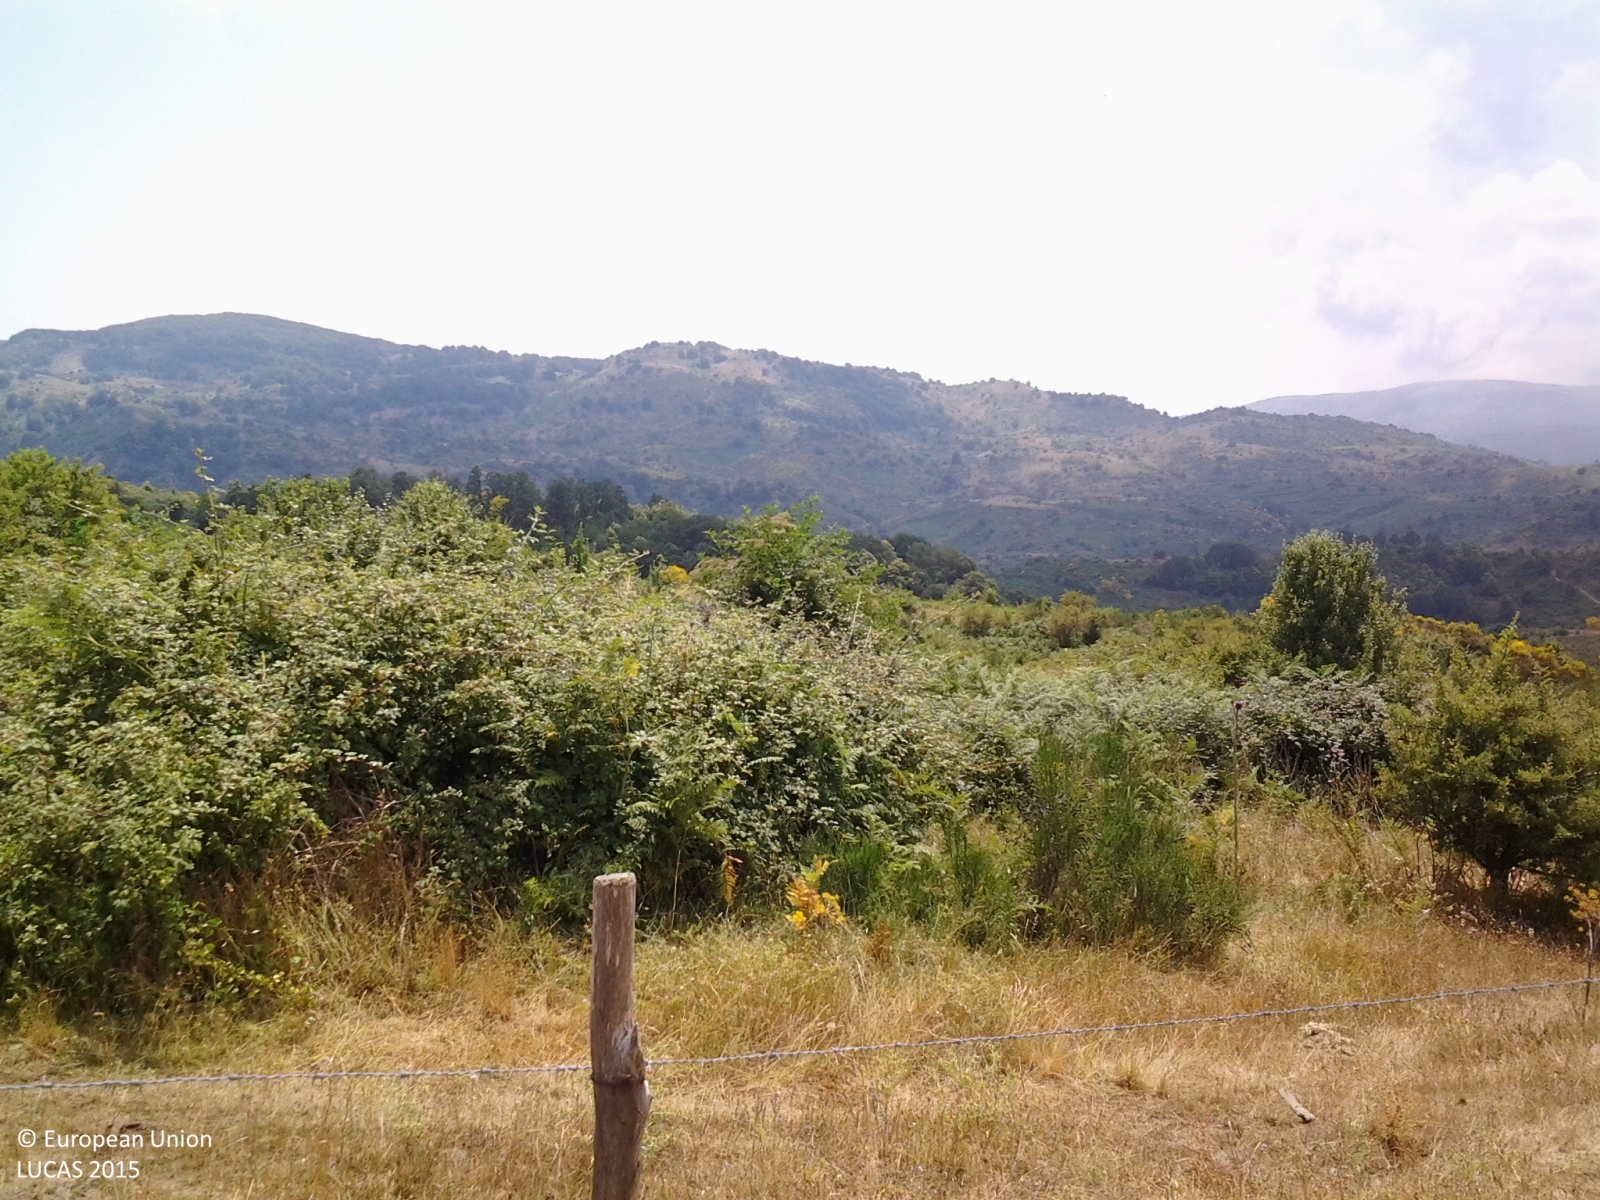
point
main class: Shrubland
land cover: Shrubland with sparse tree cover
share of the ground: > 75 %
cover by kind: shrubs 80 %, unconsolidated bare surface 10 %, broadleaved forest trees 5 %, herbaceous plants 5 %
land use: Agriculture (excluding fallow land and kitchen gardens)
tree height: < 5 m
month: July
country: IT
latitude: 37.9668
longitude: 14.8958
